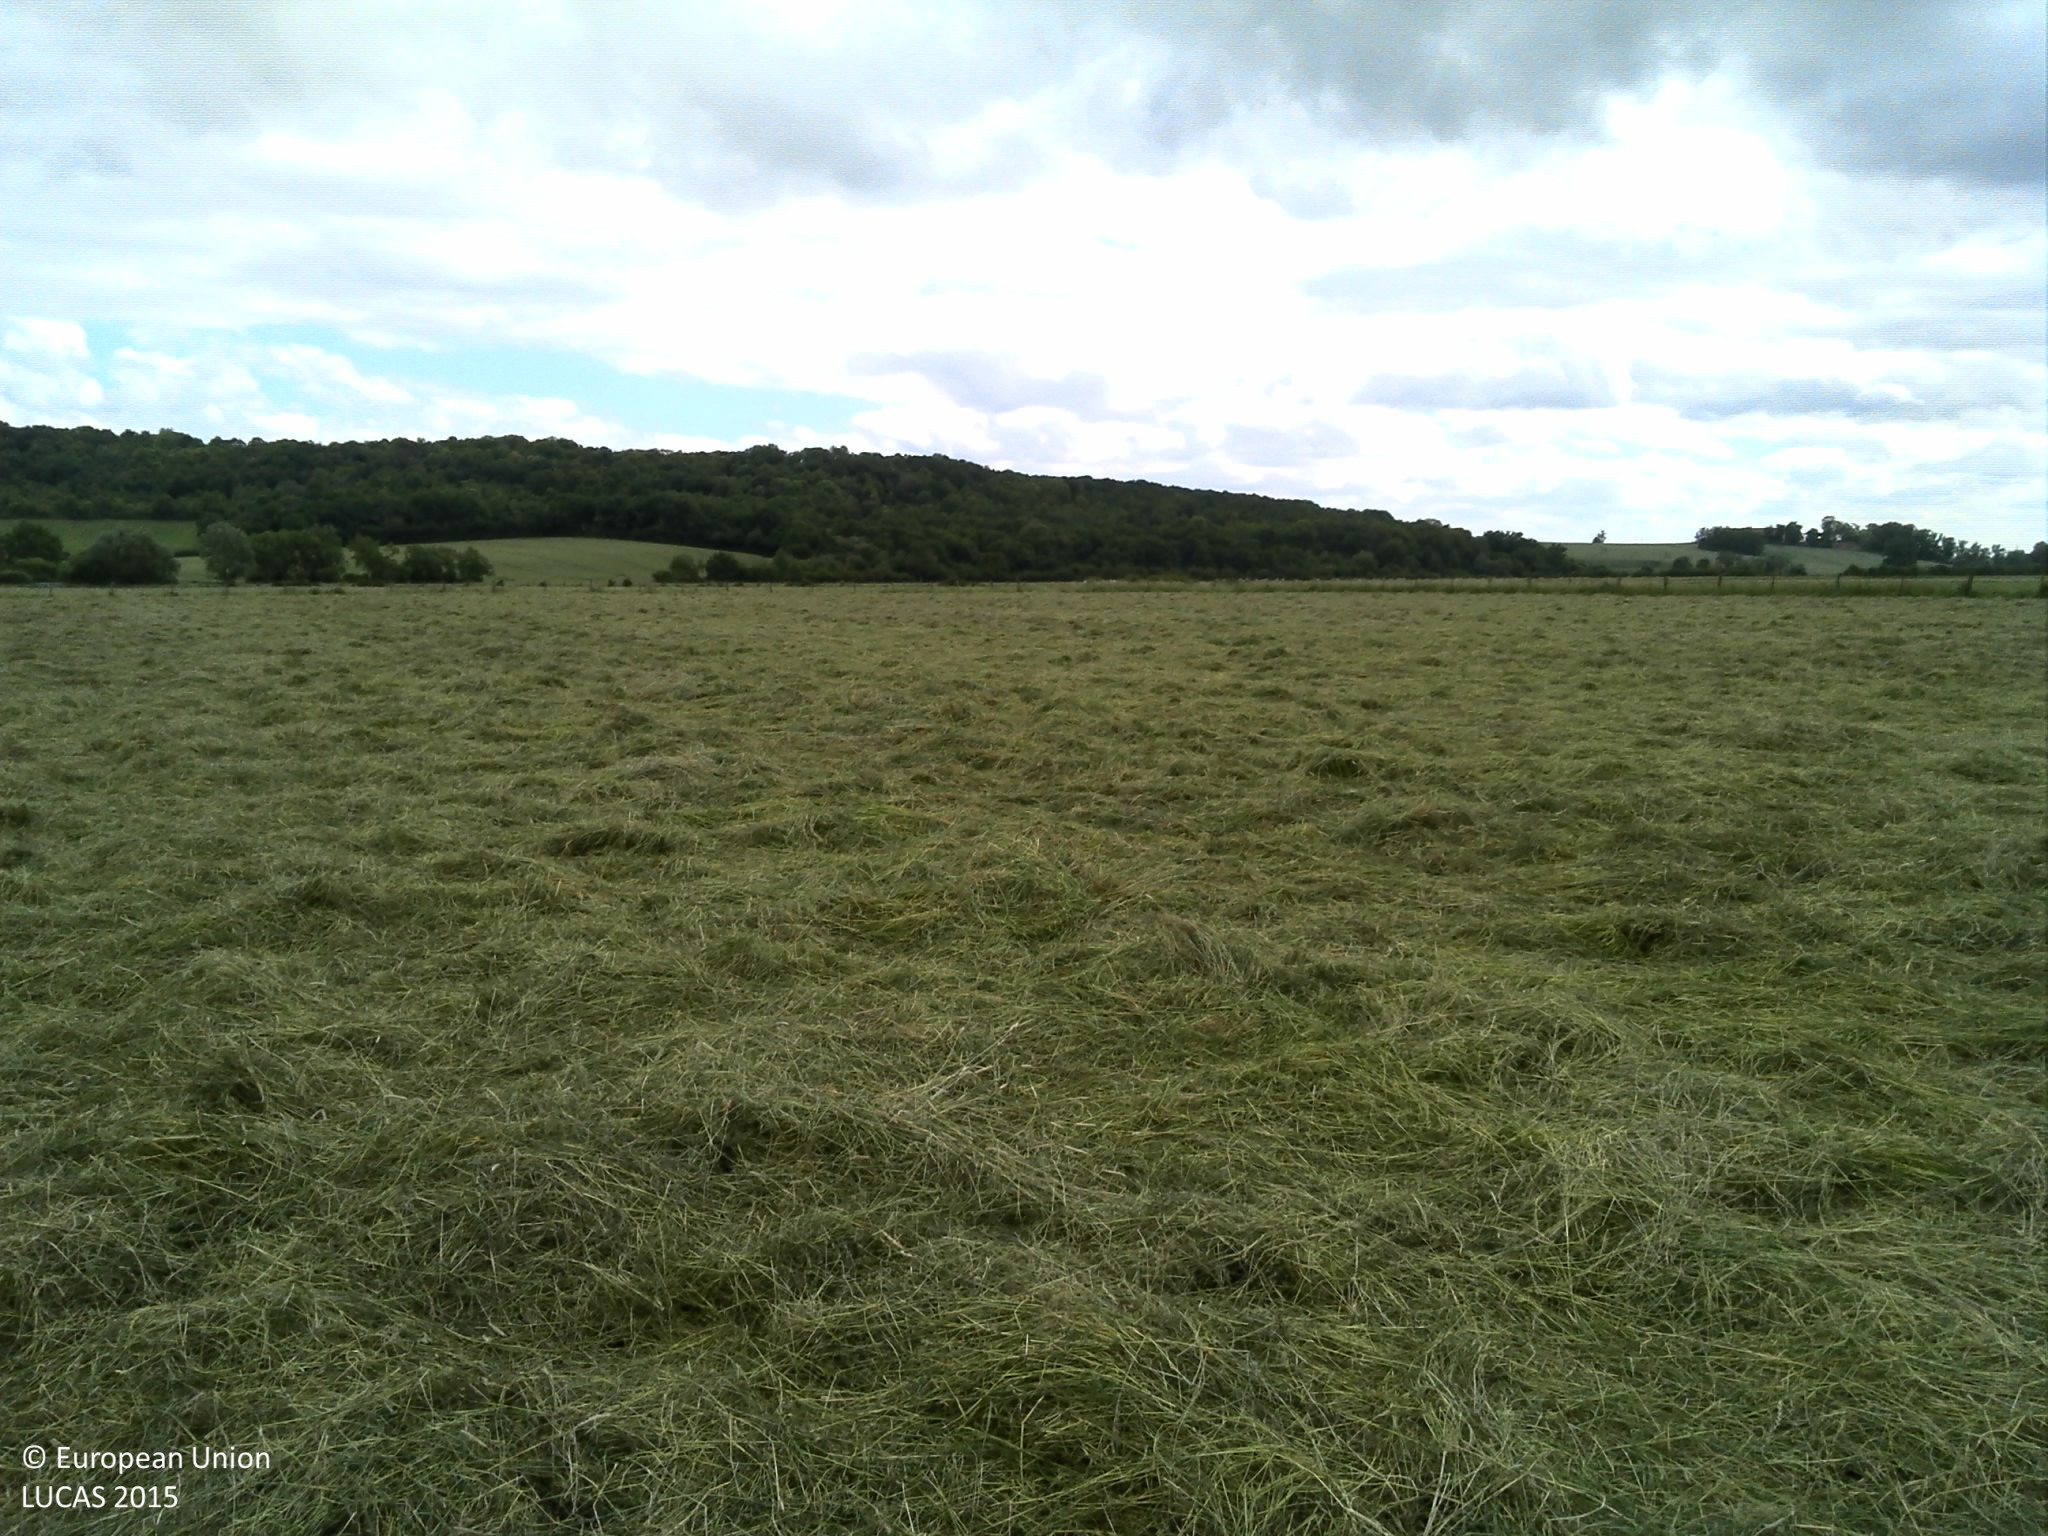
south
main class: Grassland
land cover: Grassland without tree/shrub cover
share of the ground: > 75 %
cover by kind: herbaceous plants 100 %
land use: Agriculture (excluding fallow land and kitchen gardens)
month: June
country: FR
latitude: 49.0221
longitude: 6.1845
